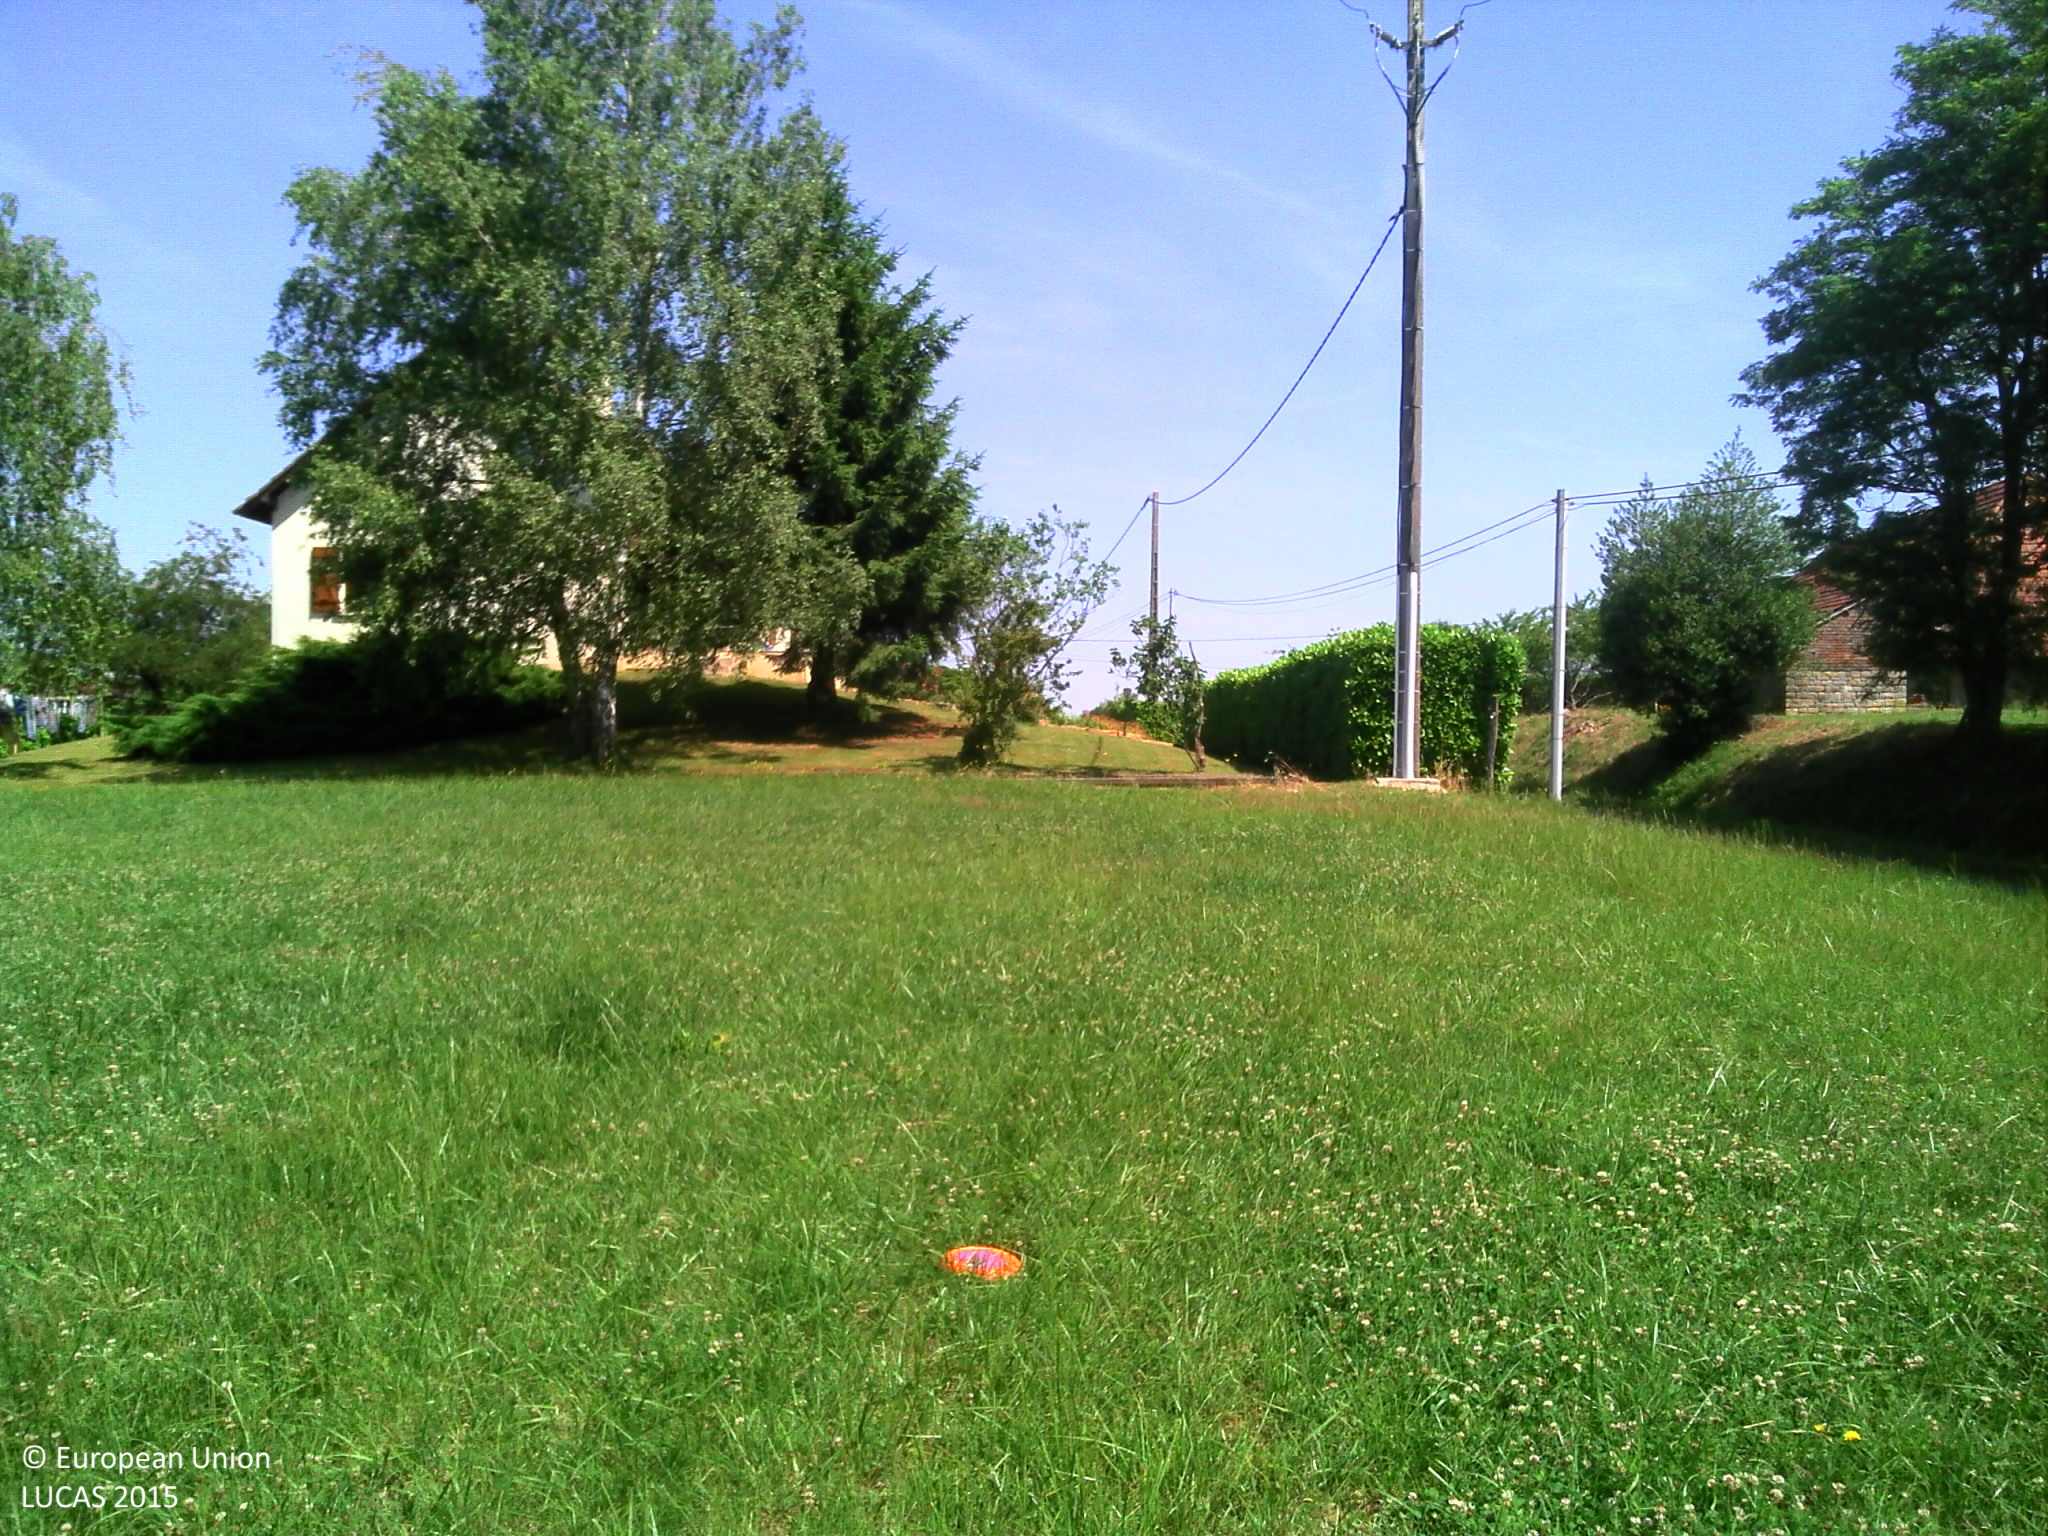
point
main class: Cropland
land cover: Clovers
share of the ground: > 75 %
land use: Agriculture (excluding fallow land and kitchen gardens)
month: June
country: FR
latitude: 46.7902
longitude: 5.3252
